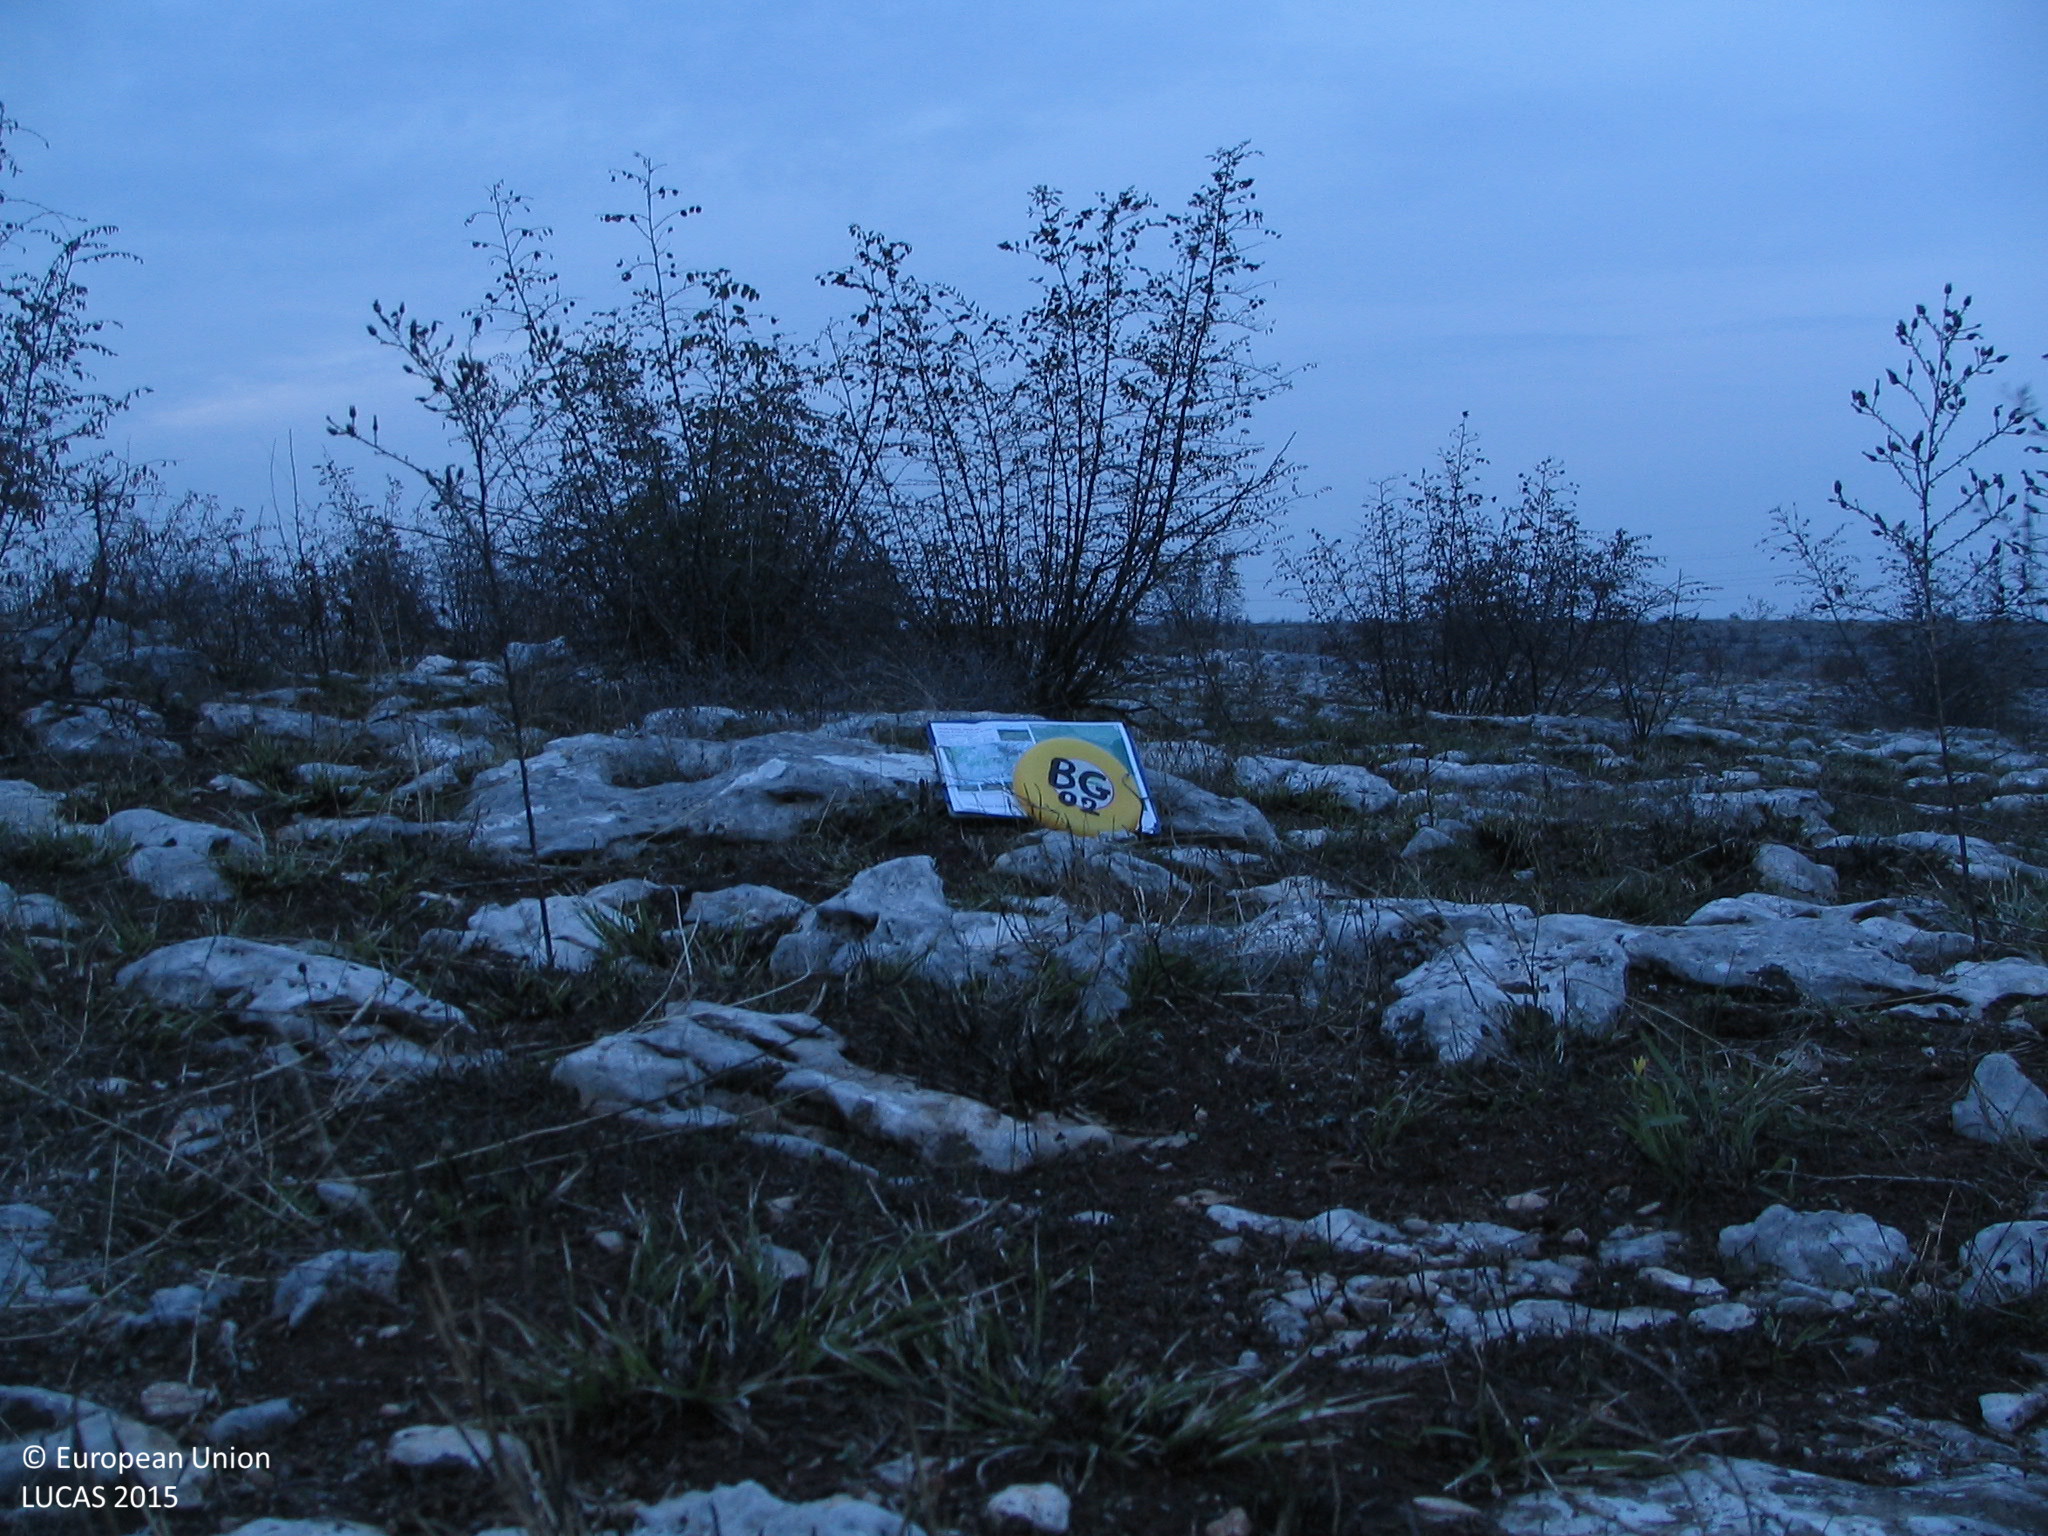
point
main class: Grassland
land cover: Grassland with sparse tree/shrub cover
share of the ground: 50 - 75 %
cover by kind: herbaceous plants 50 %, consolidated bare surface 40 %, broadleaved forest trees 5 %, shrubs 5 %
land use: Abandoned areas
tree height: < 5 m
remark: Burnt area
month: October
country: BG
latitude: 43.1934
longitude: 24.1419
